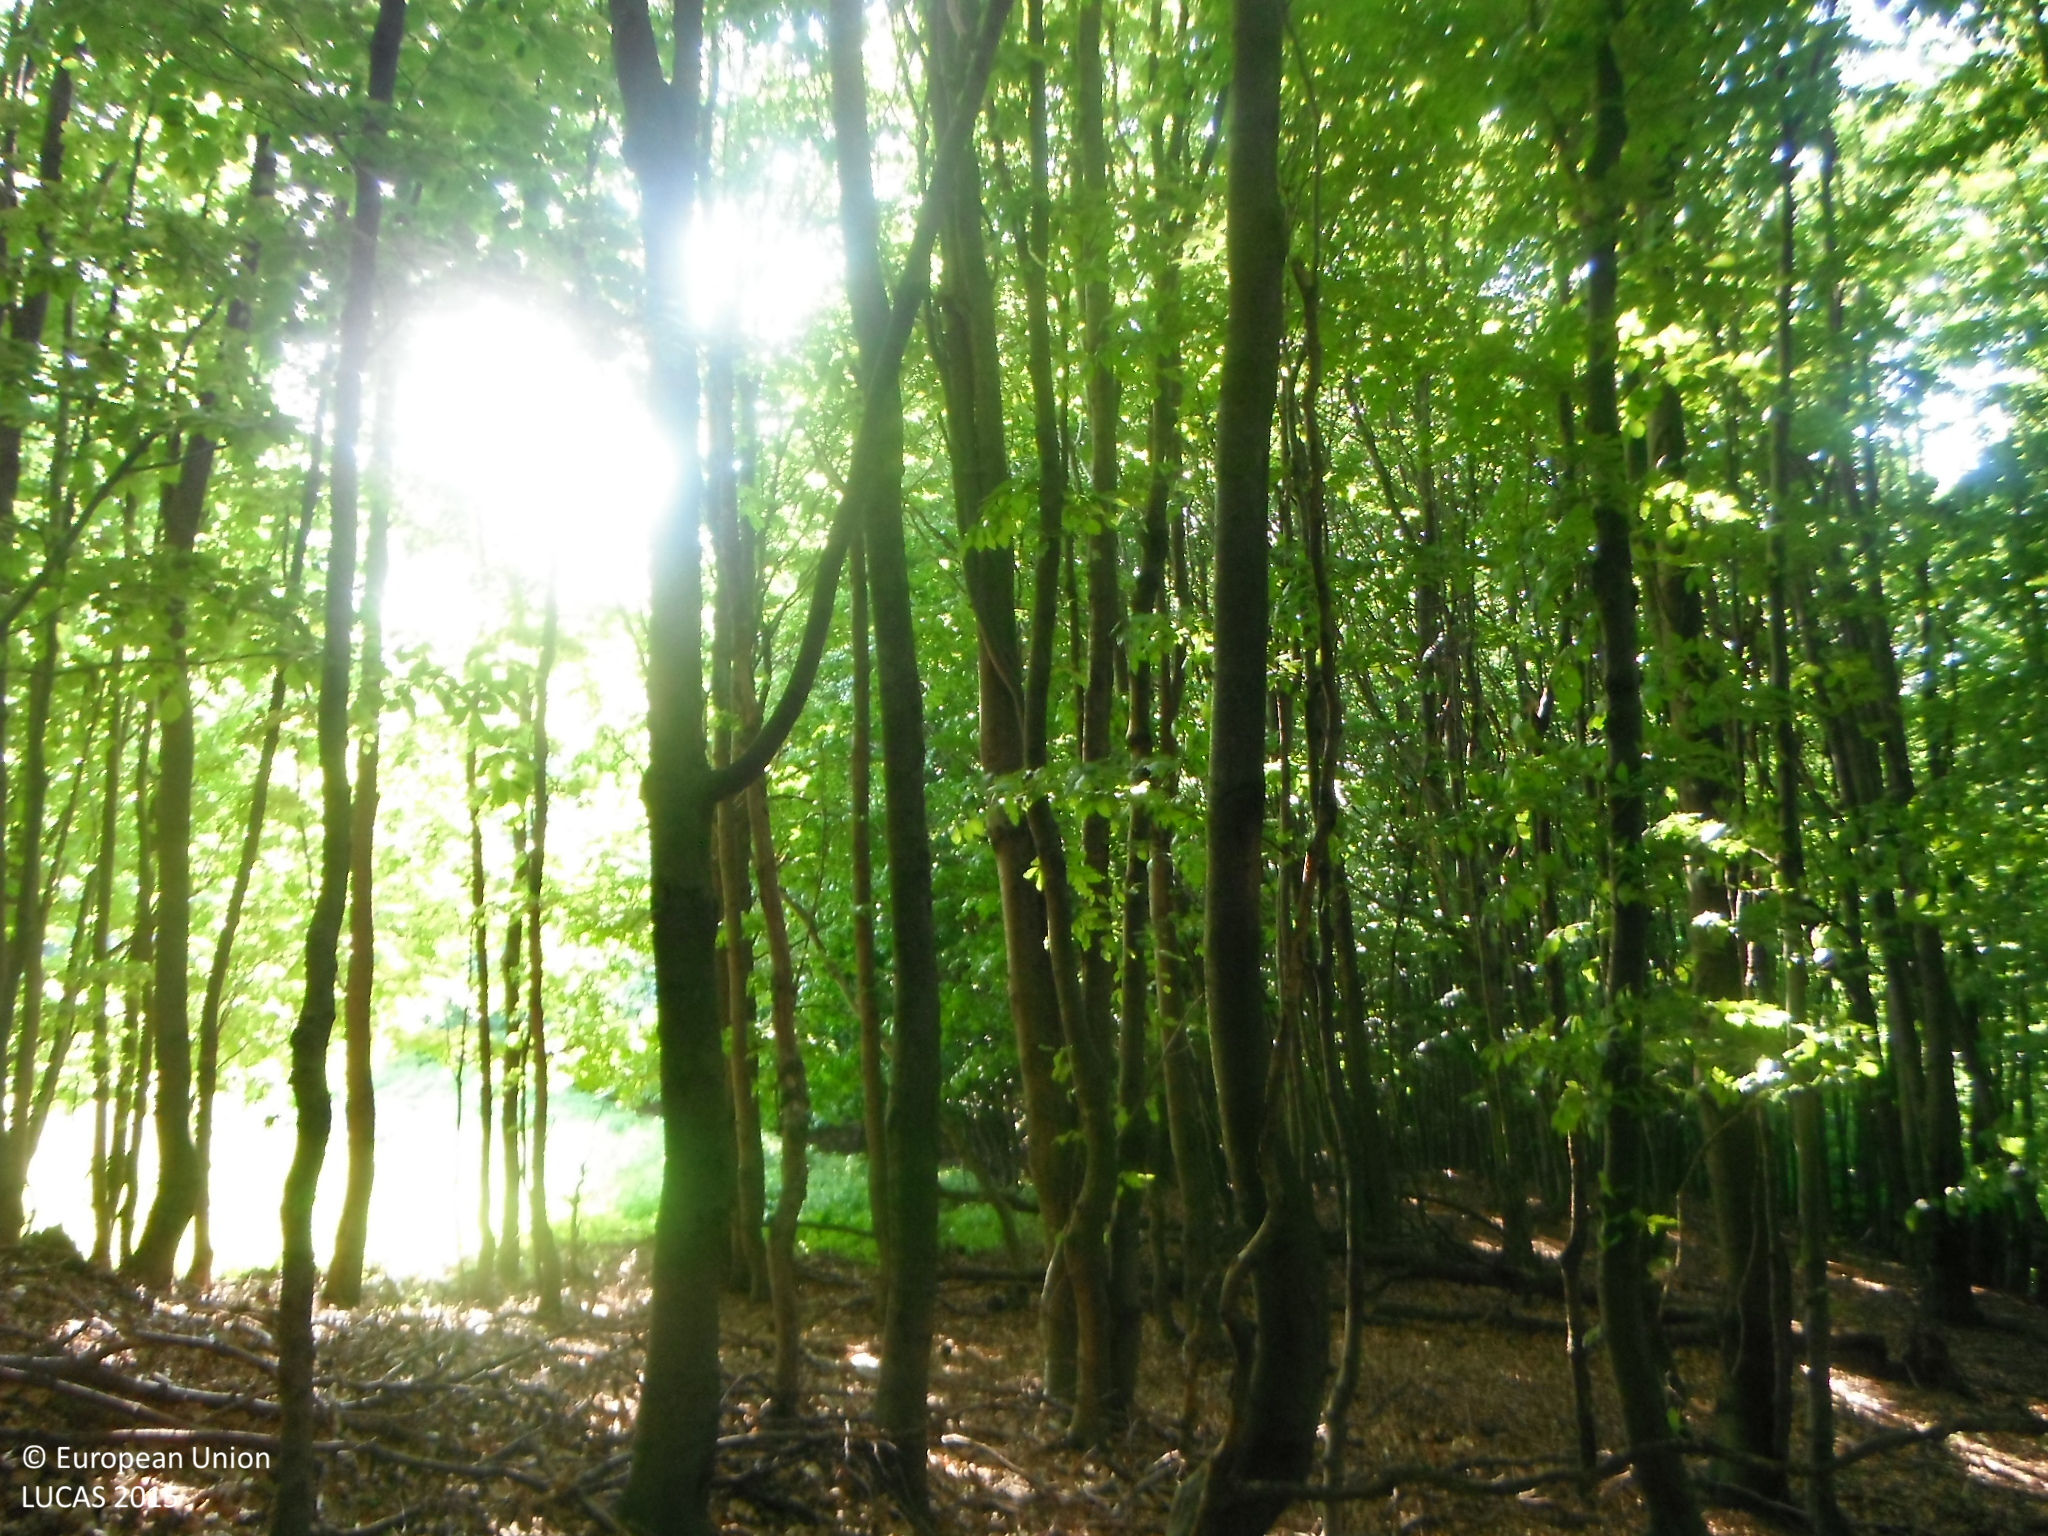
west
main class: Woodland
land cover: Broadleaved woodland
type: beech forest
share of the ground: > 75 %
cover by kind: broadleaved forest trees 100 %
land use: Forestry
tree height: > 5 m
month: June
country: SK
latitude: 48.4173
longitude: 17.2650
